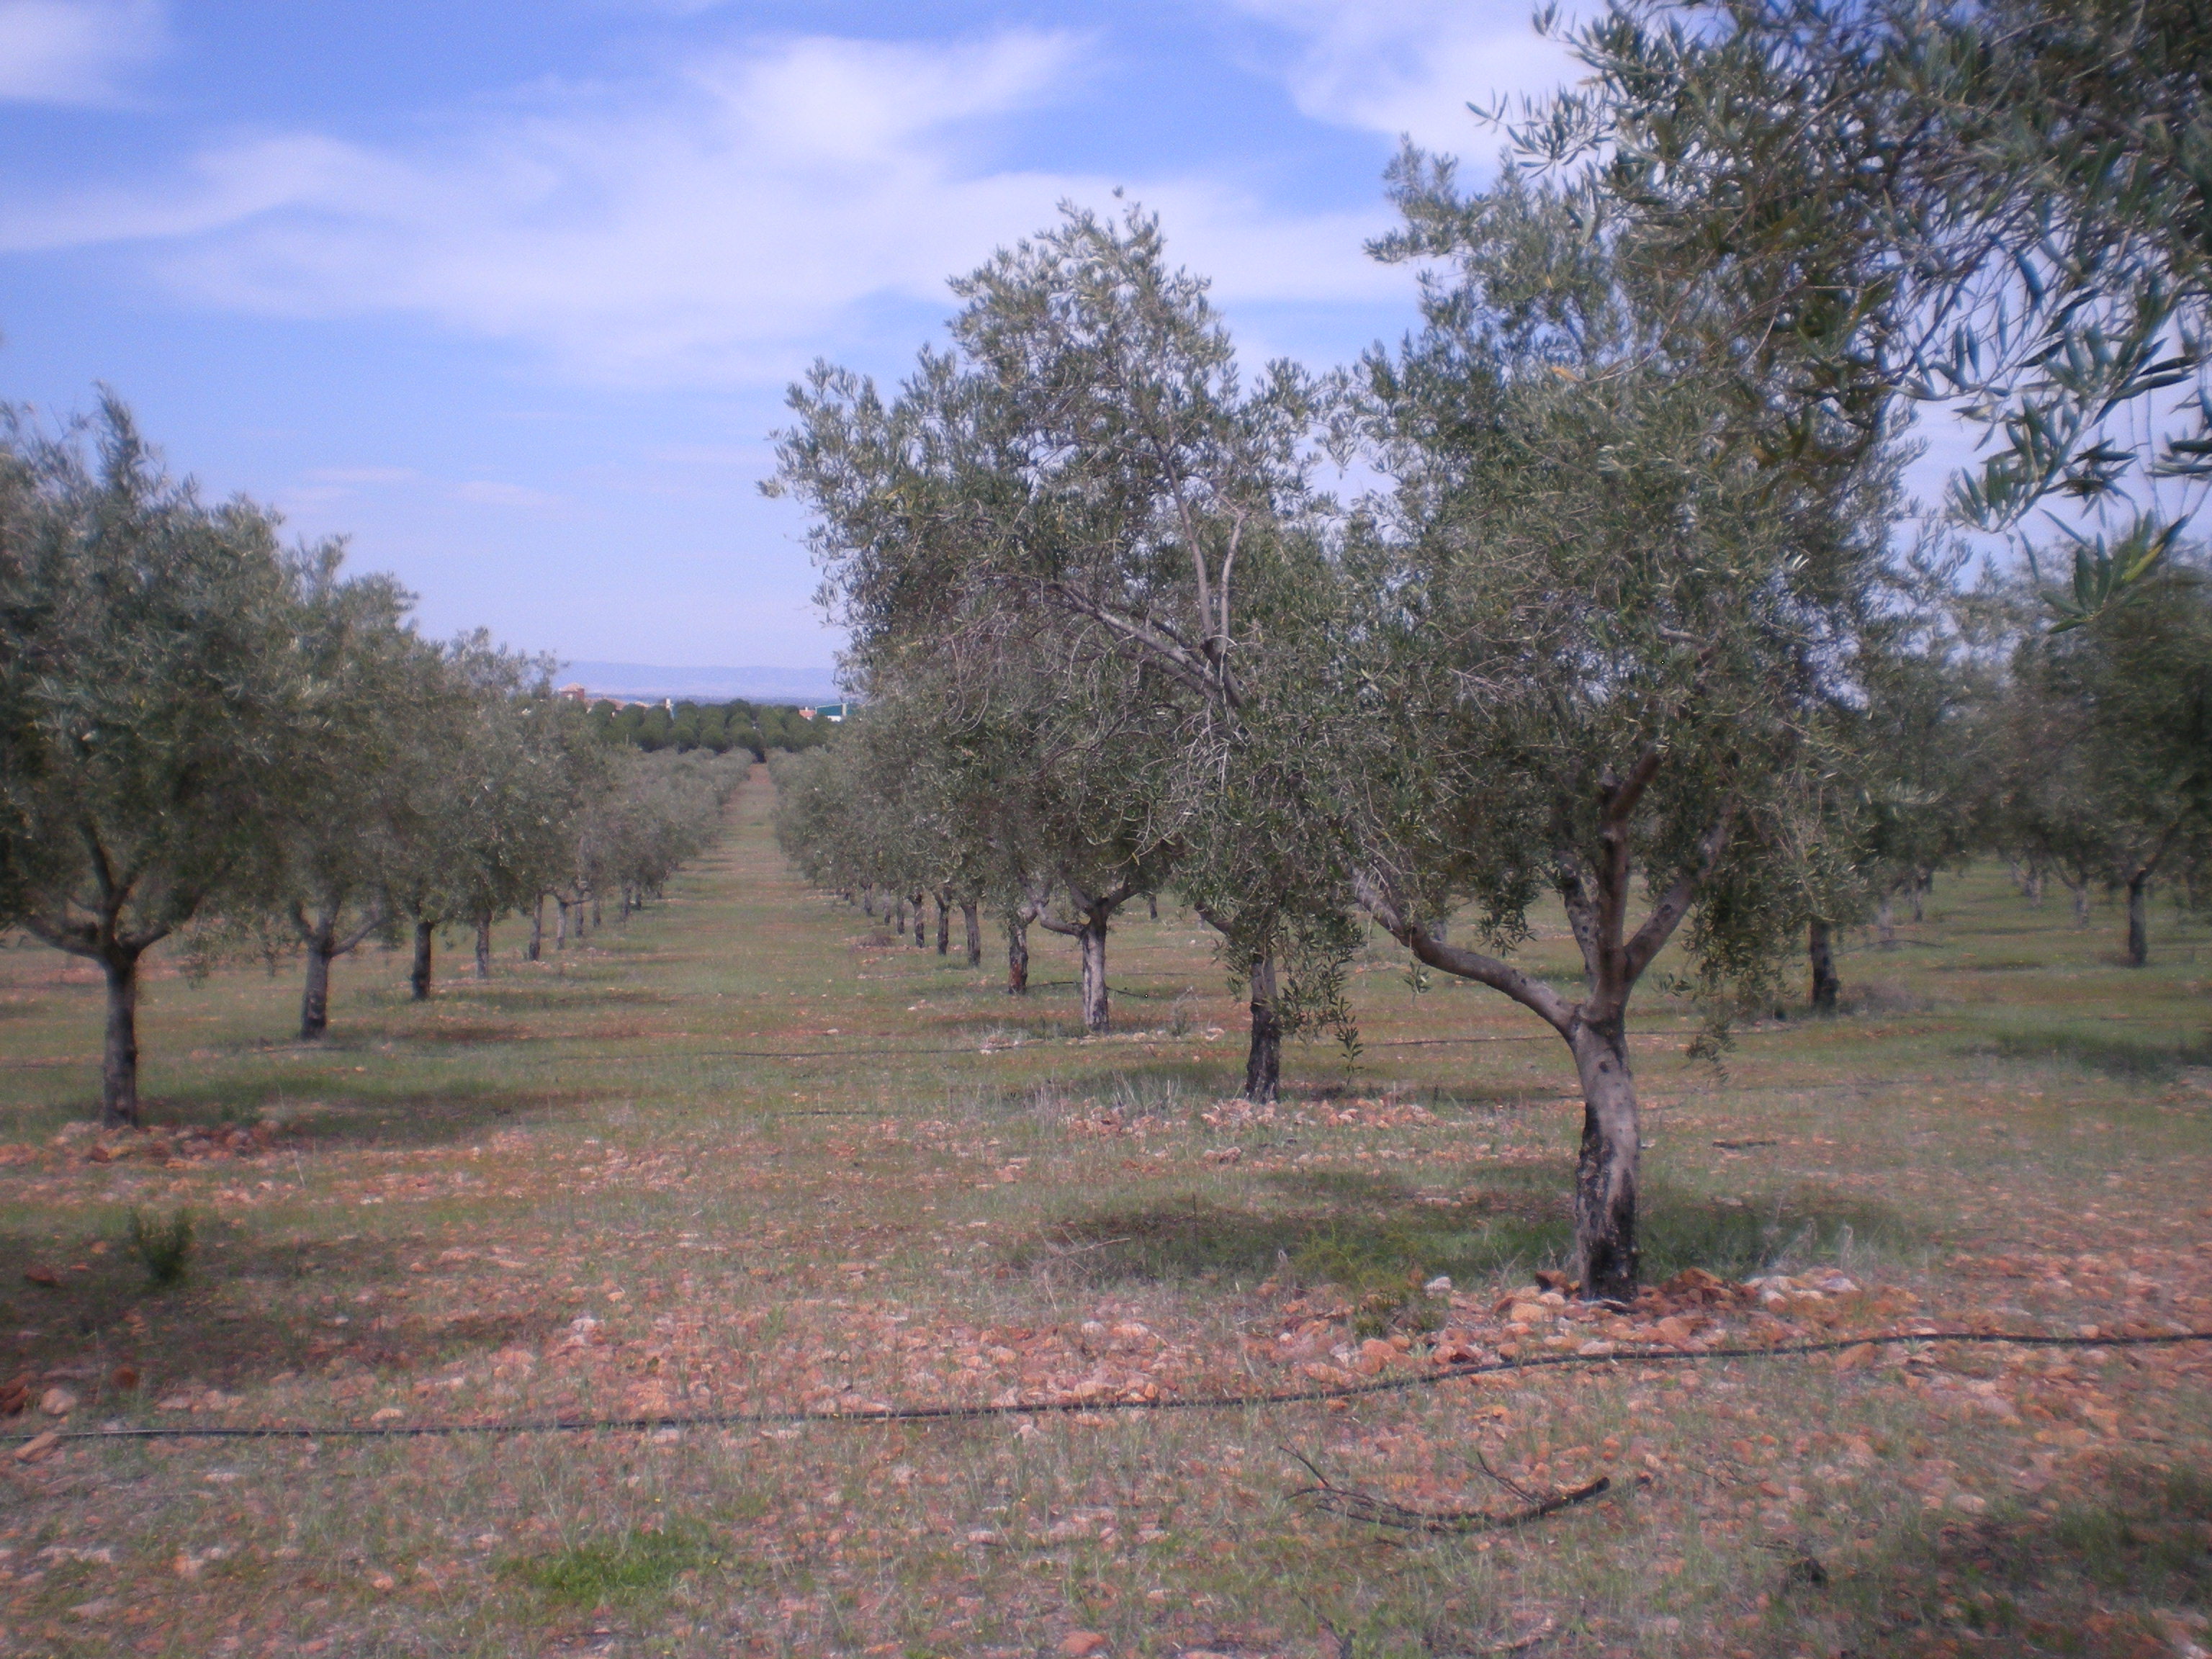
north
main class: Cropland
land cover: Olive groves
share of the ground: 10 - 25 %
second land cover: Other bare soil
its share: > 75 %
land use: Agriculture (excluding fallow land and kitchen gardens)
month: April
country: ES
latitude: 38.8571
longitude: -3.6010
